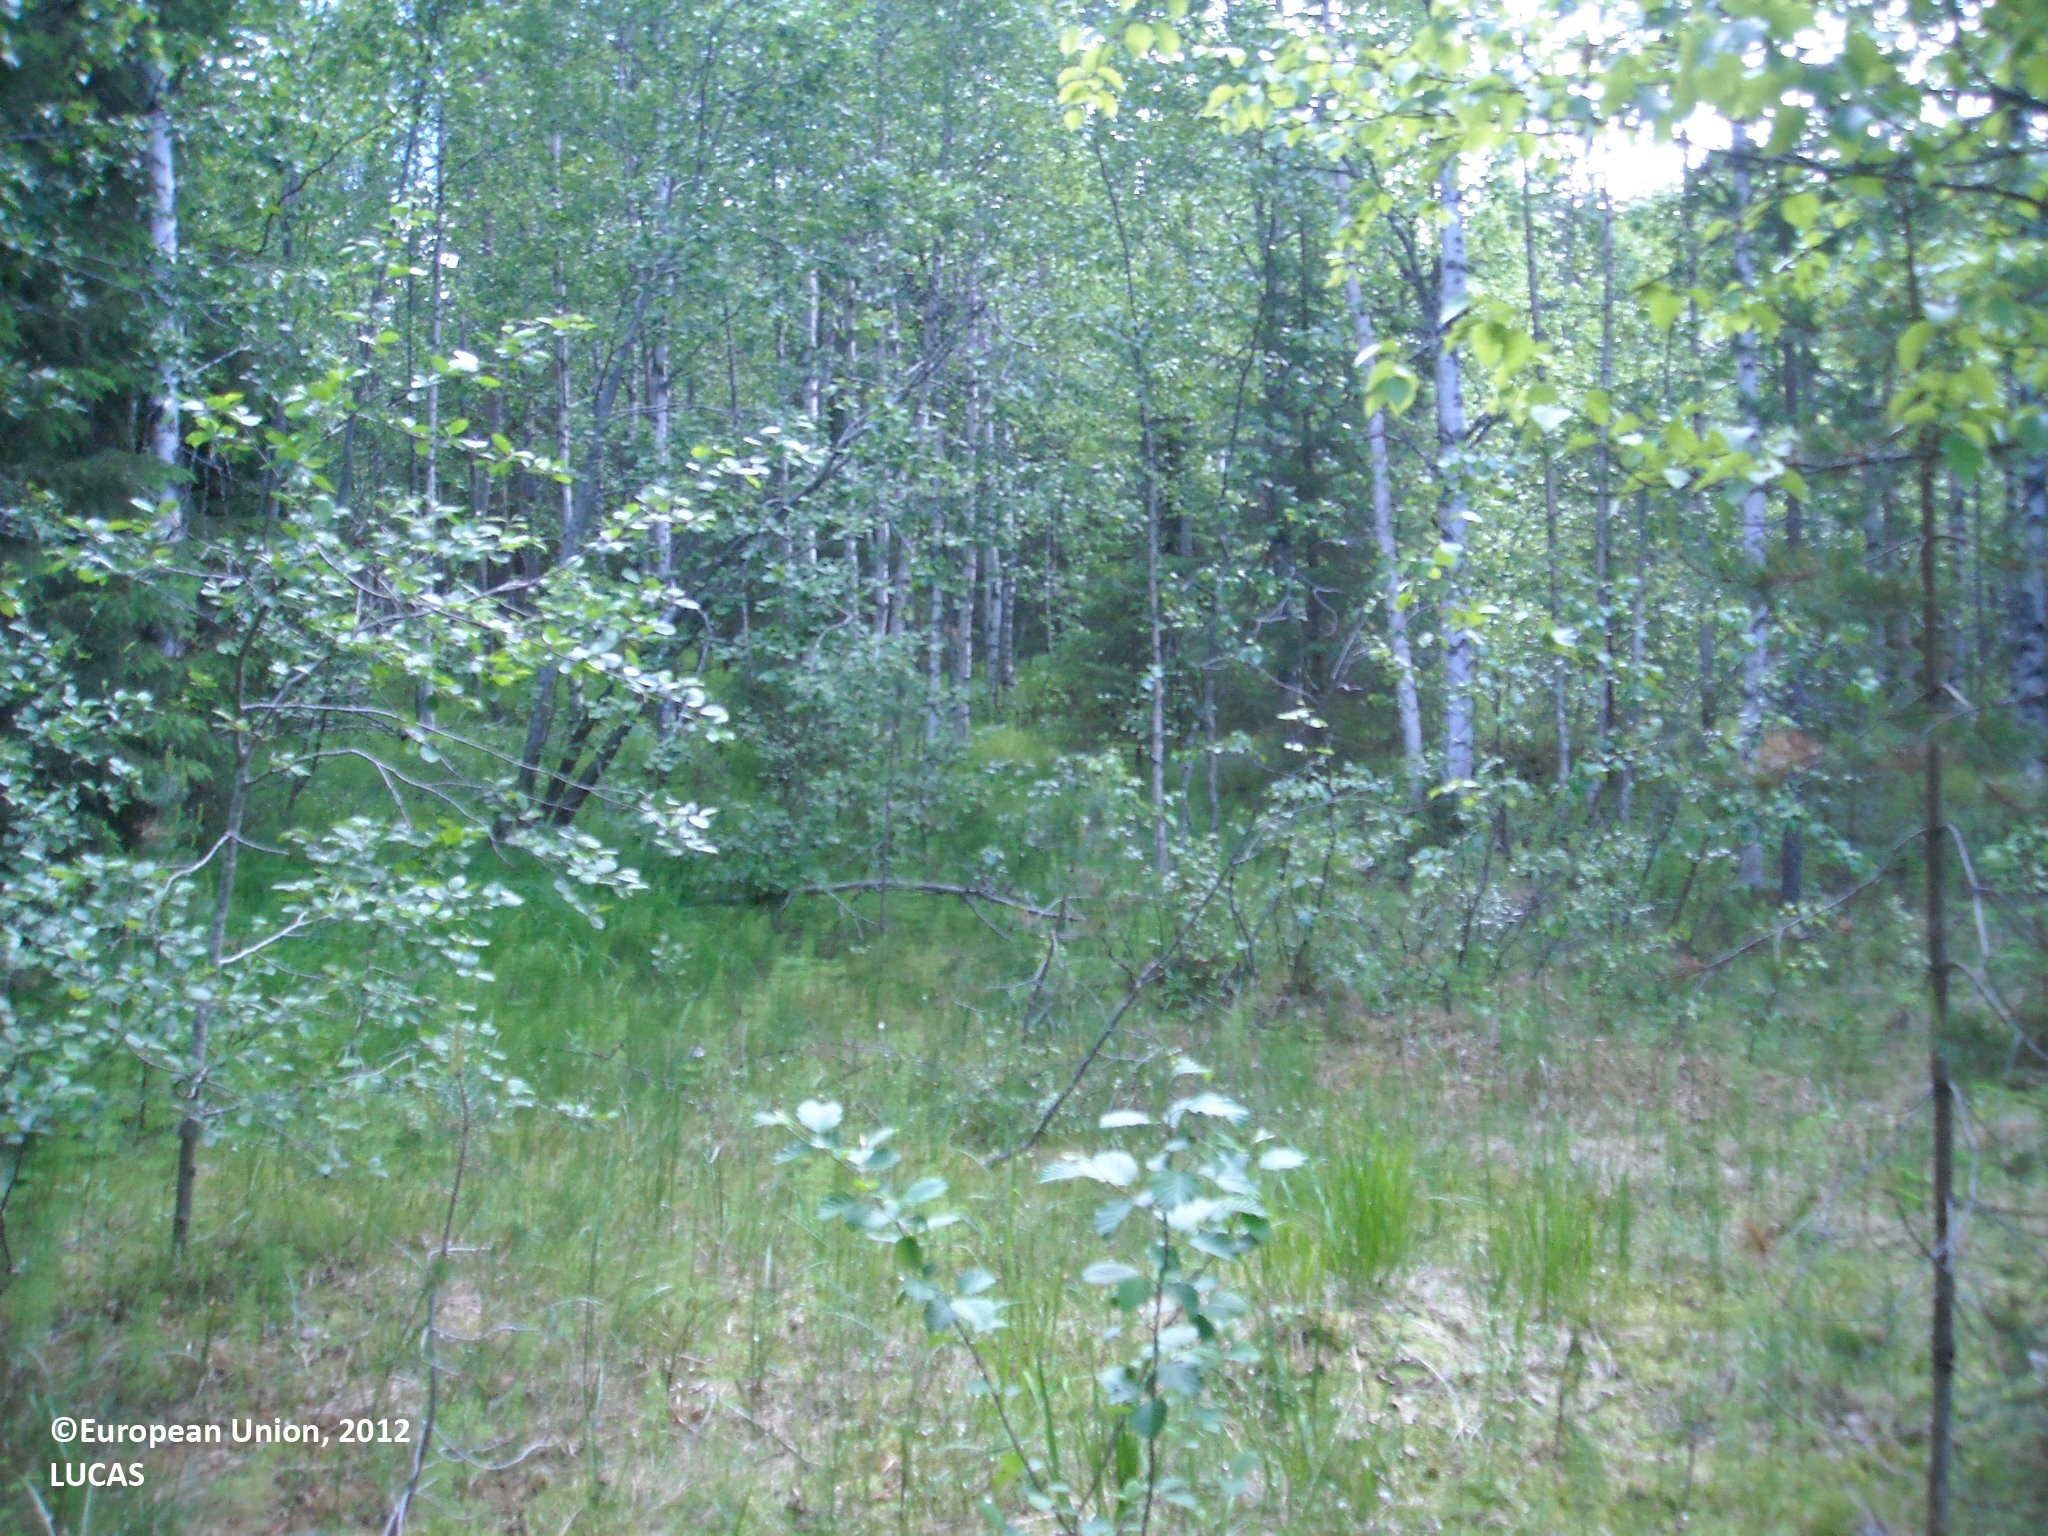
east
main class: Woodland
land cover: Other mixed woodland
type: mire and swamp forests
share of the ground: 50 - 75 %
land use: Forestry
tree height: > 5 m
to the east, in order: Other mixed woodland; Ditches and canals; Other mixed woodland; Ditches and canals; Other mixed woodland; Ditches and canals; Other mixed woodland; Ditches and canals; Spruce dominated mixed woodland; Spruce dominated coniferous woodland; Ditches and canals; Spruce dominated coniferous woodland
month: July
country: FI
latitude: 64.6769
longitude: 27.6850
